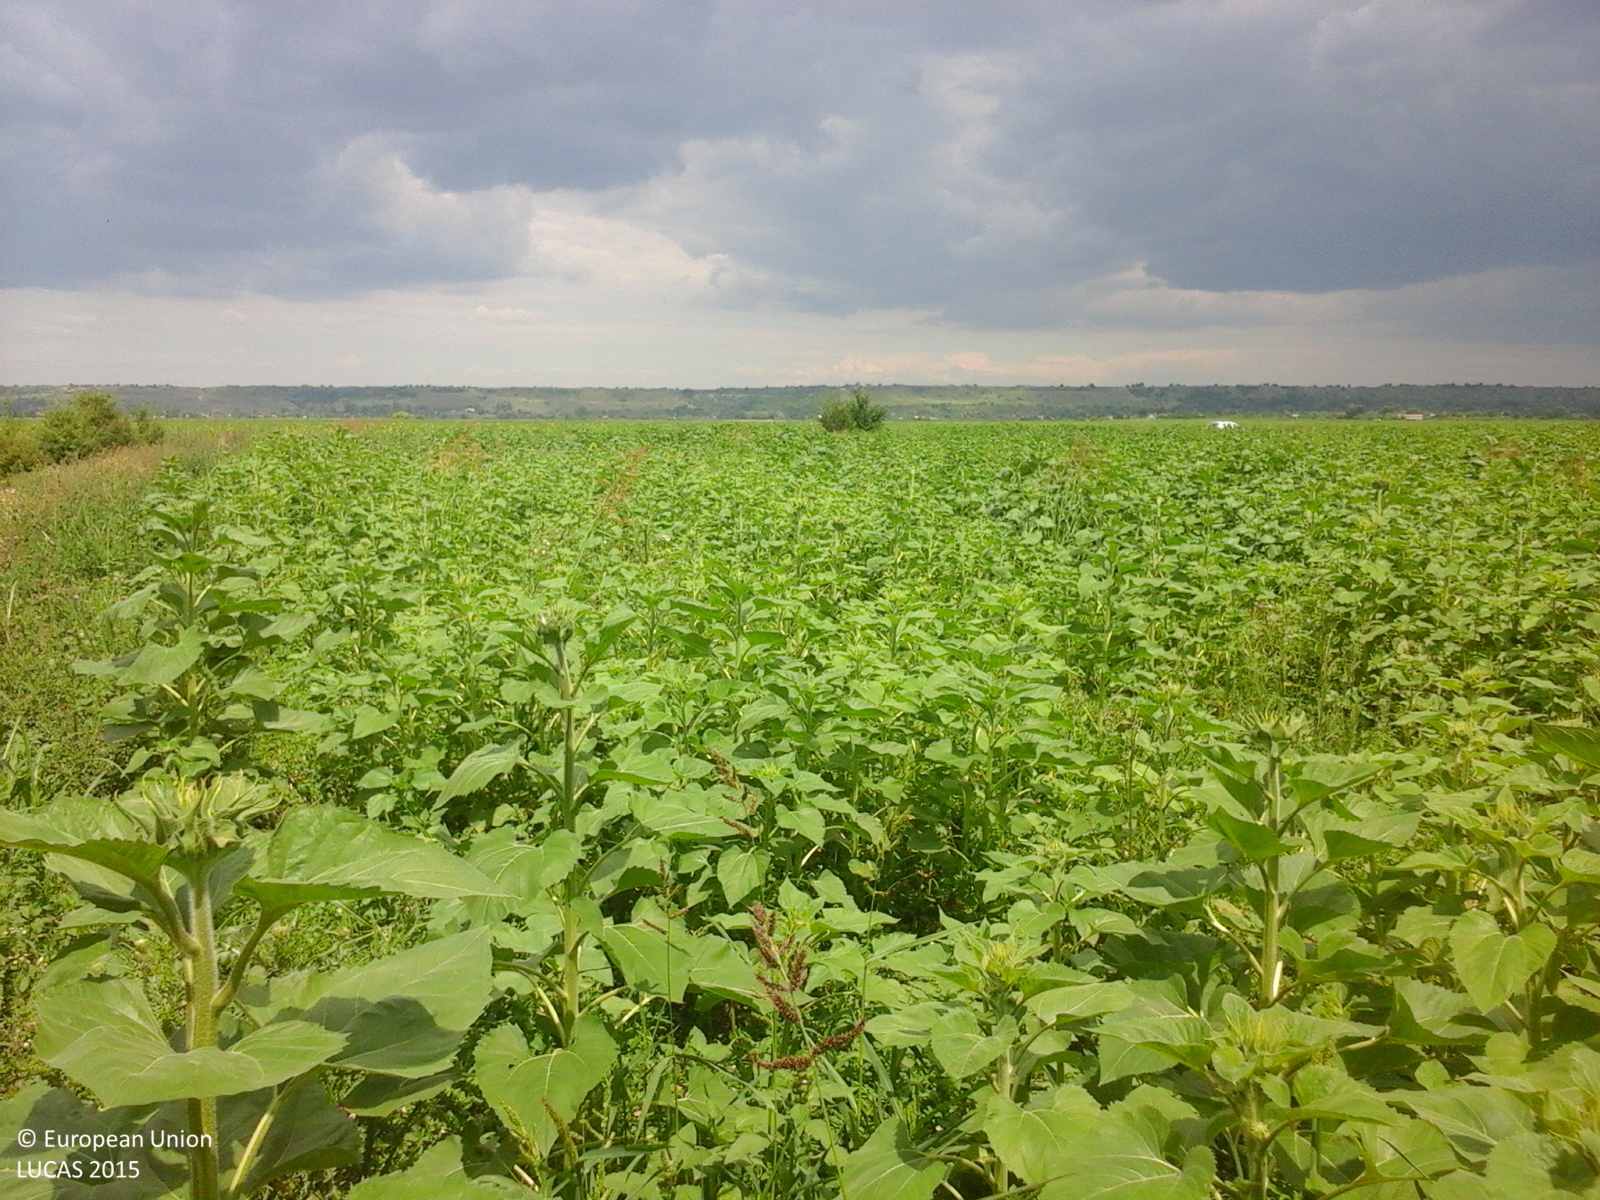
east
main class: Cropland
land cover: Sunflower
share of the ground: > 75 %
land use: Agriculture (excluding fallow land and kitchen gardens)
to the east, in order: Sunflower; Spontaneously vegetated surfaces; Ditches and canals; Spontaneously vegetated surfaces; Sunflower
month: July
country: RO
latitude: 44.0213
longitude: 24.6278
